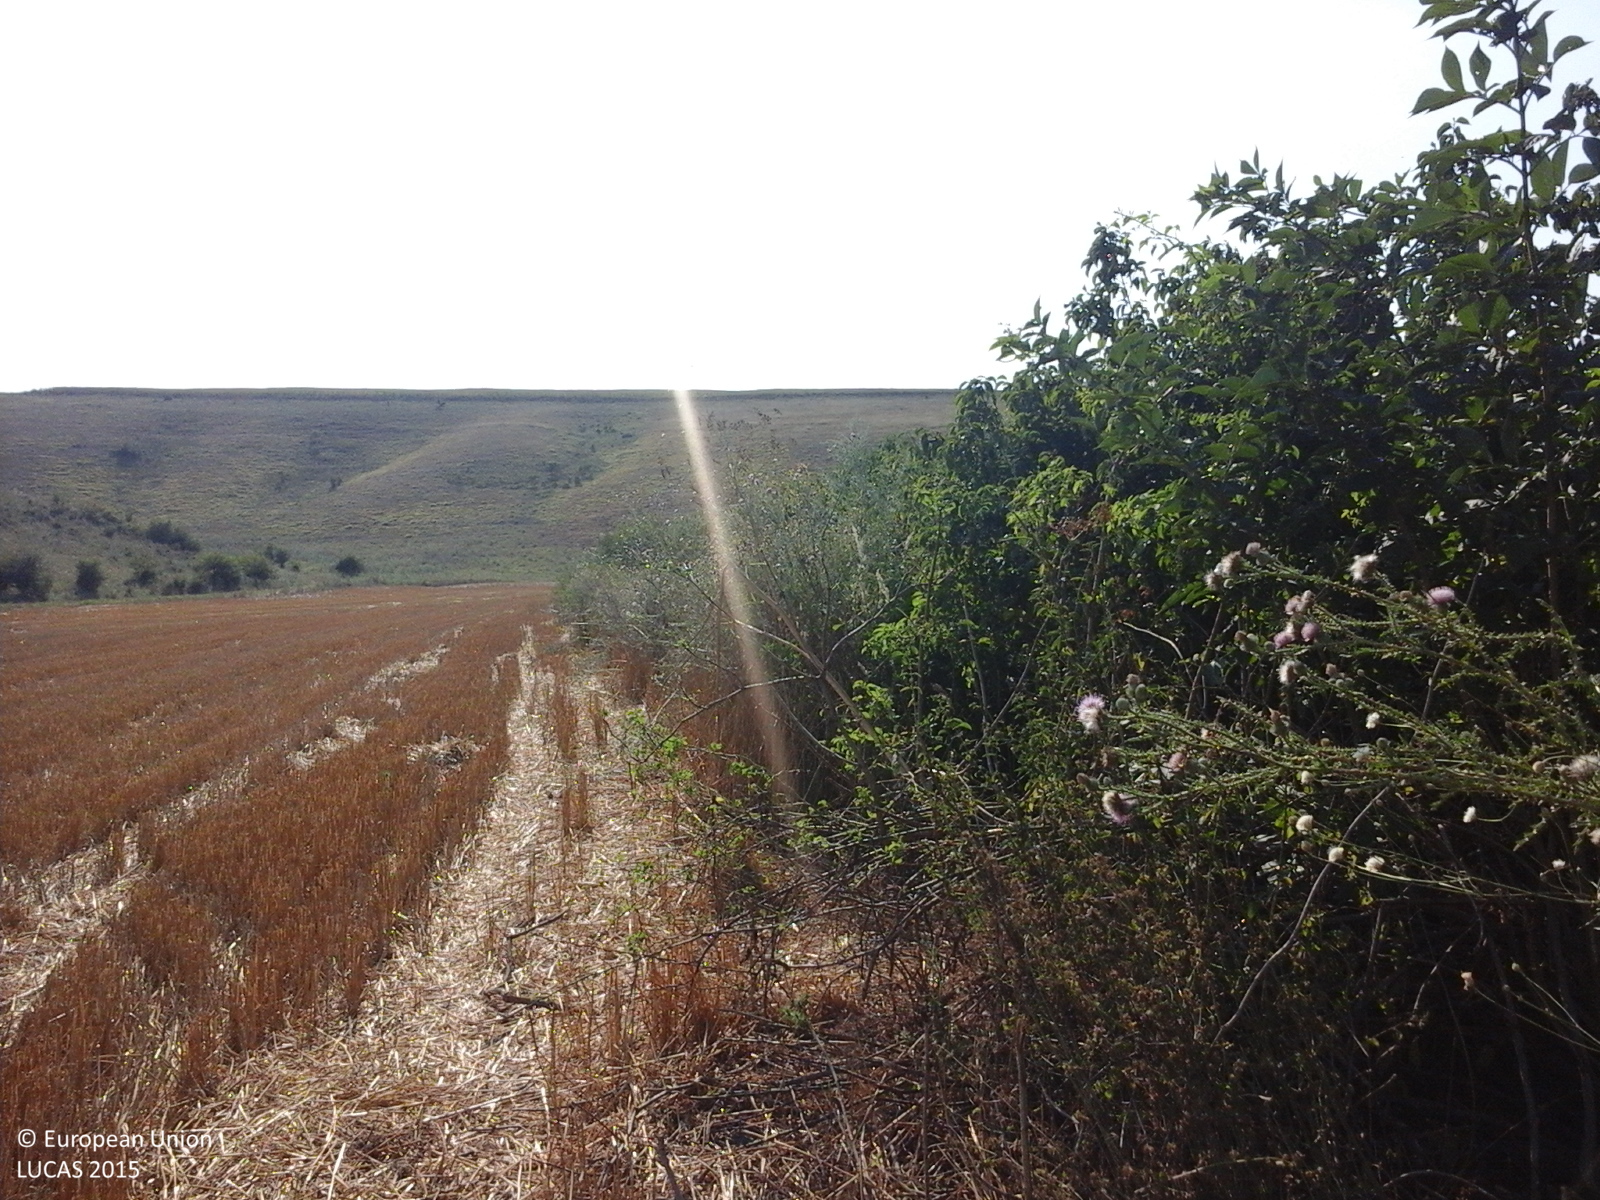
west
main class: Cropland
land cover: Common wheat
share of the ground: > 75 %
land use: Agriculture (excluding fallow land and kitchen gardens)
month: August
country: RO
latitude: 44.0842
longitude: 28.0248
